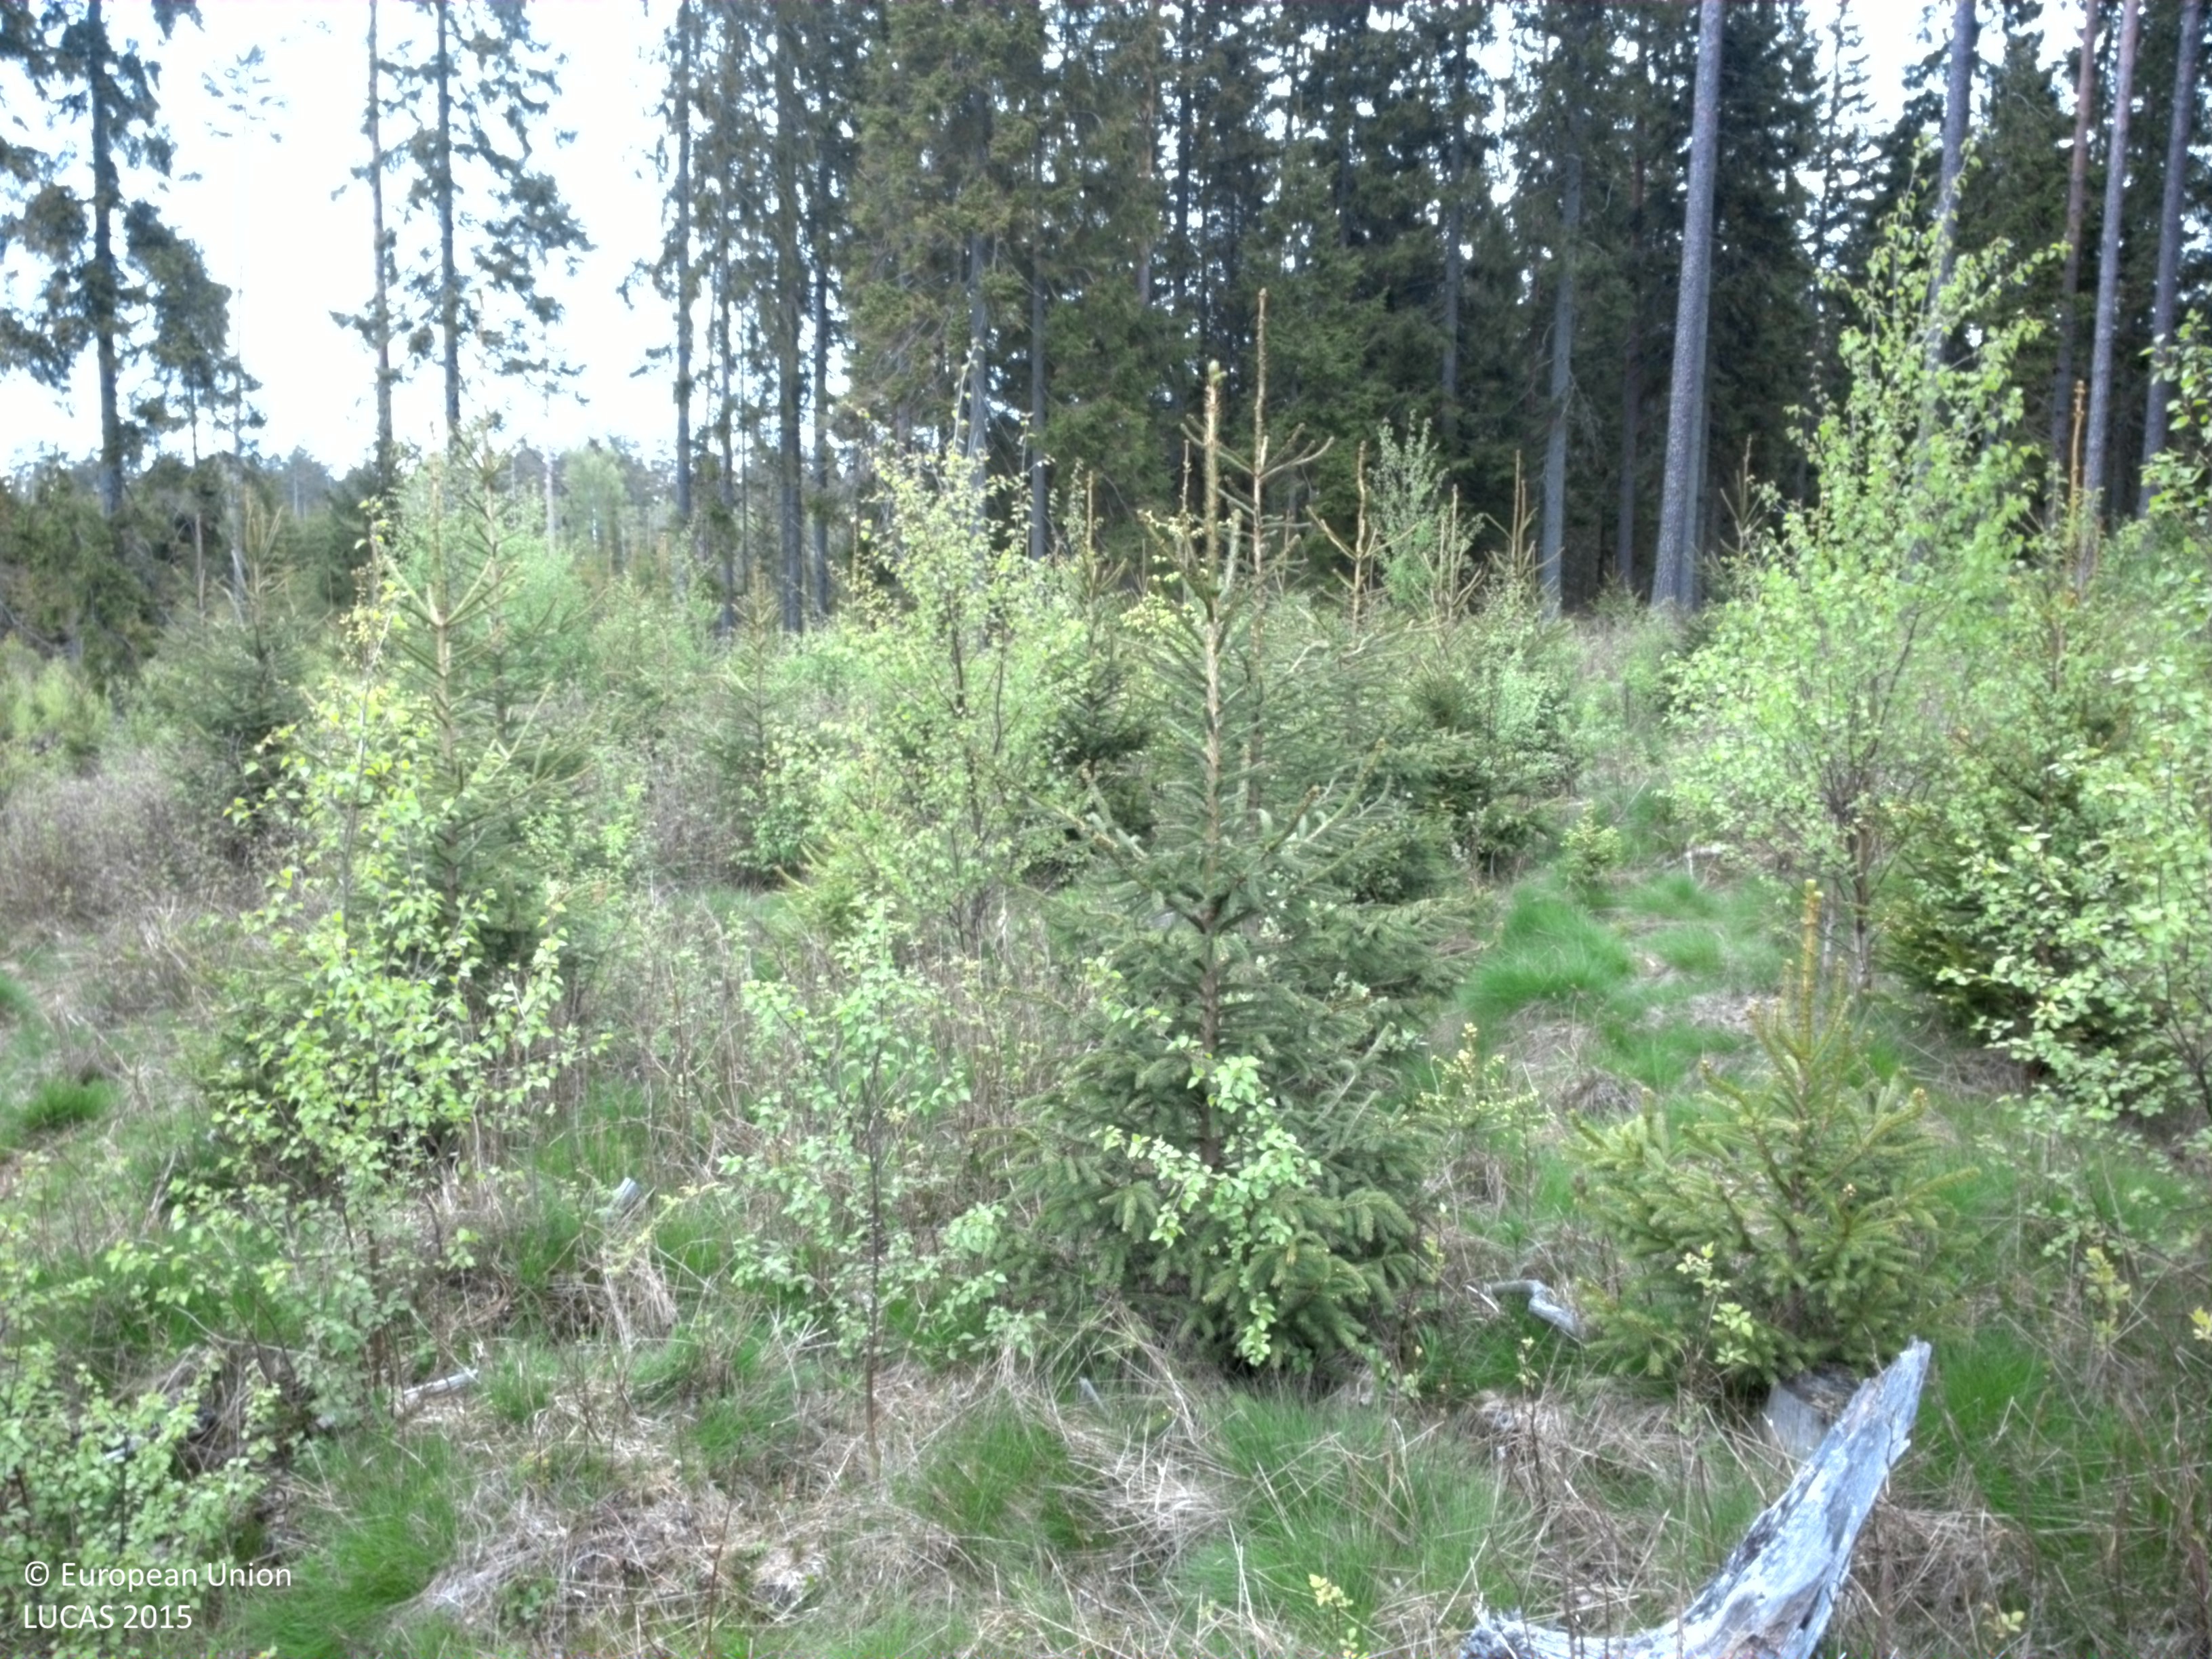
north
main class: Woodland
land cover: Broadleaved woodland
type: hemiboreal forest and nemoral coniferous forest and mixed broadleaved-coniferous forest
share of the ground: 50 - 75 %
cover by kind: broadleaved forest trees 60 %, herbaceous plants 20 %, coniferous forest trees 10 %, shrubs 5 %, lichens and mosses 5 %
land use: Forestry
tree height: < 5 m
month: May
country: SE
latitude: 56.9880
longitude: 15.0826
